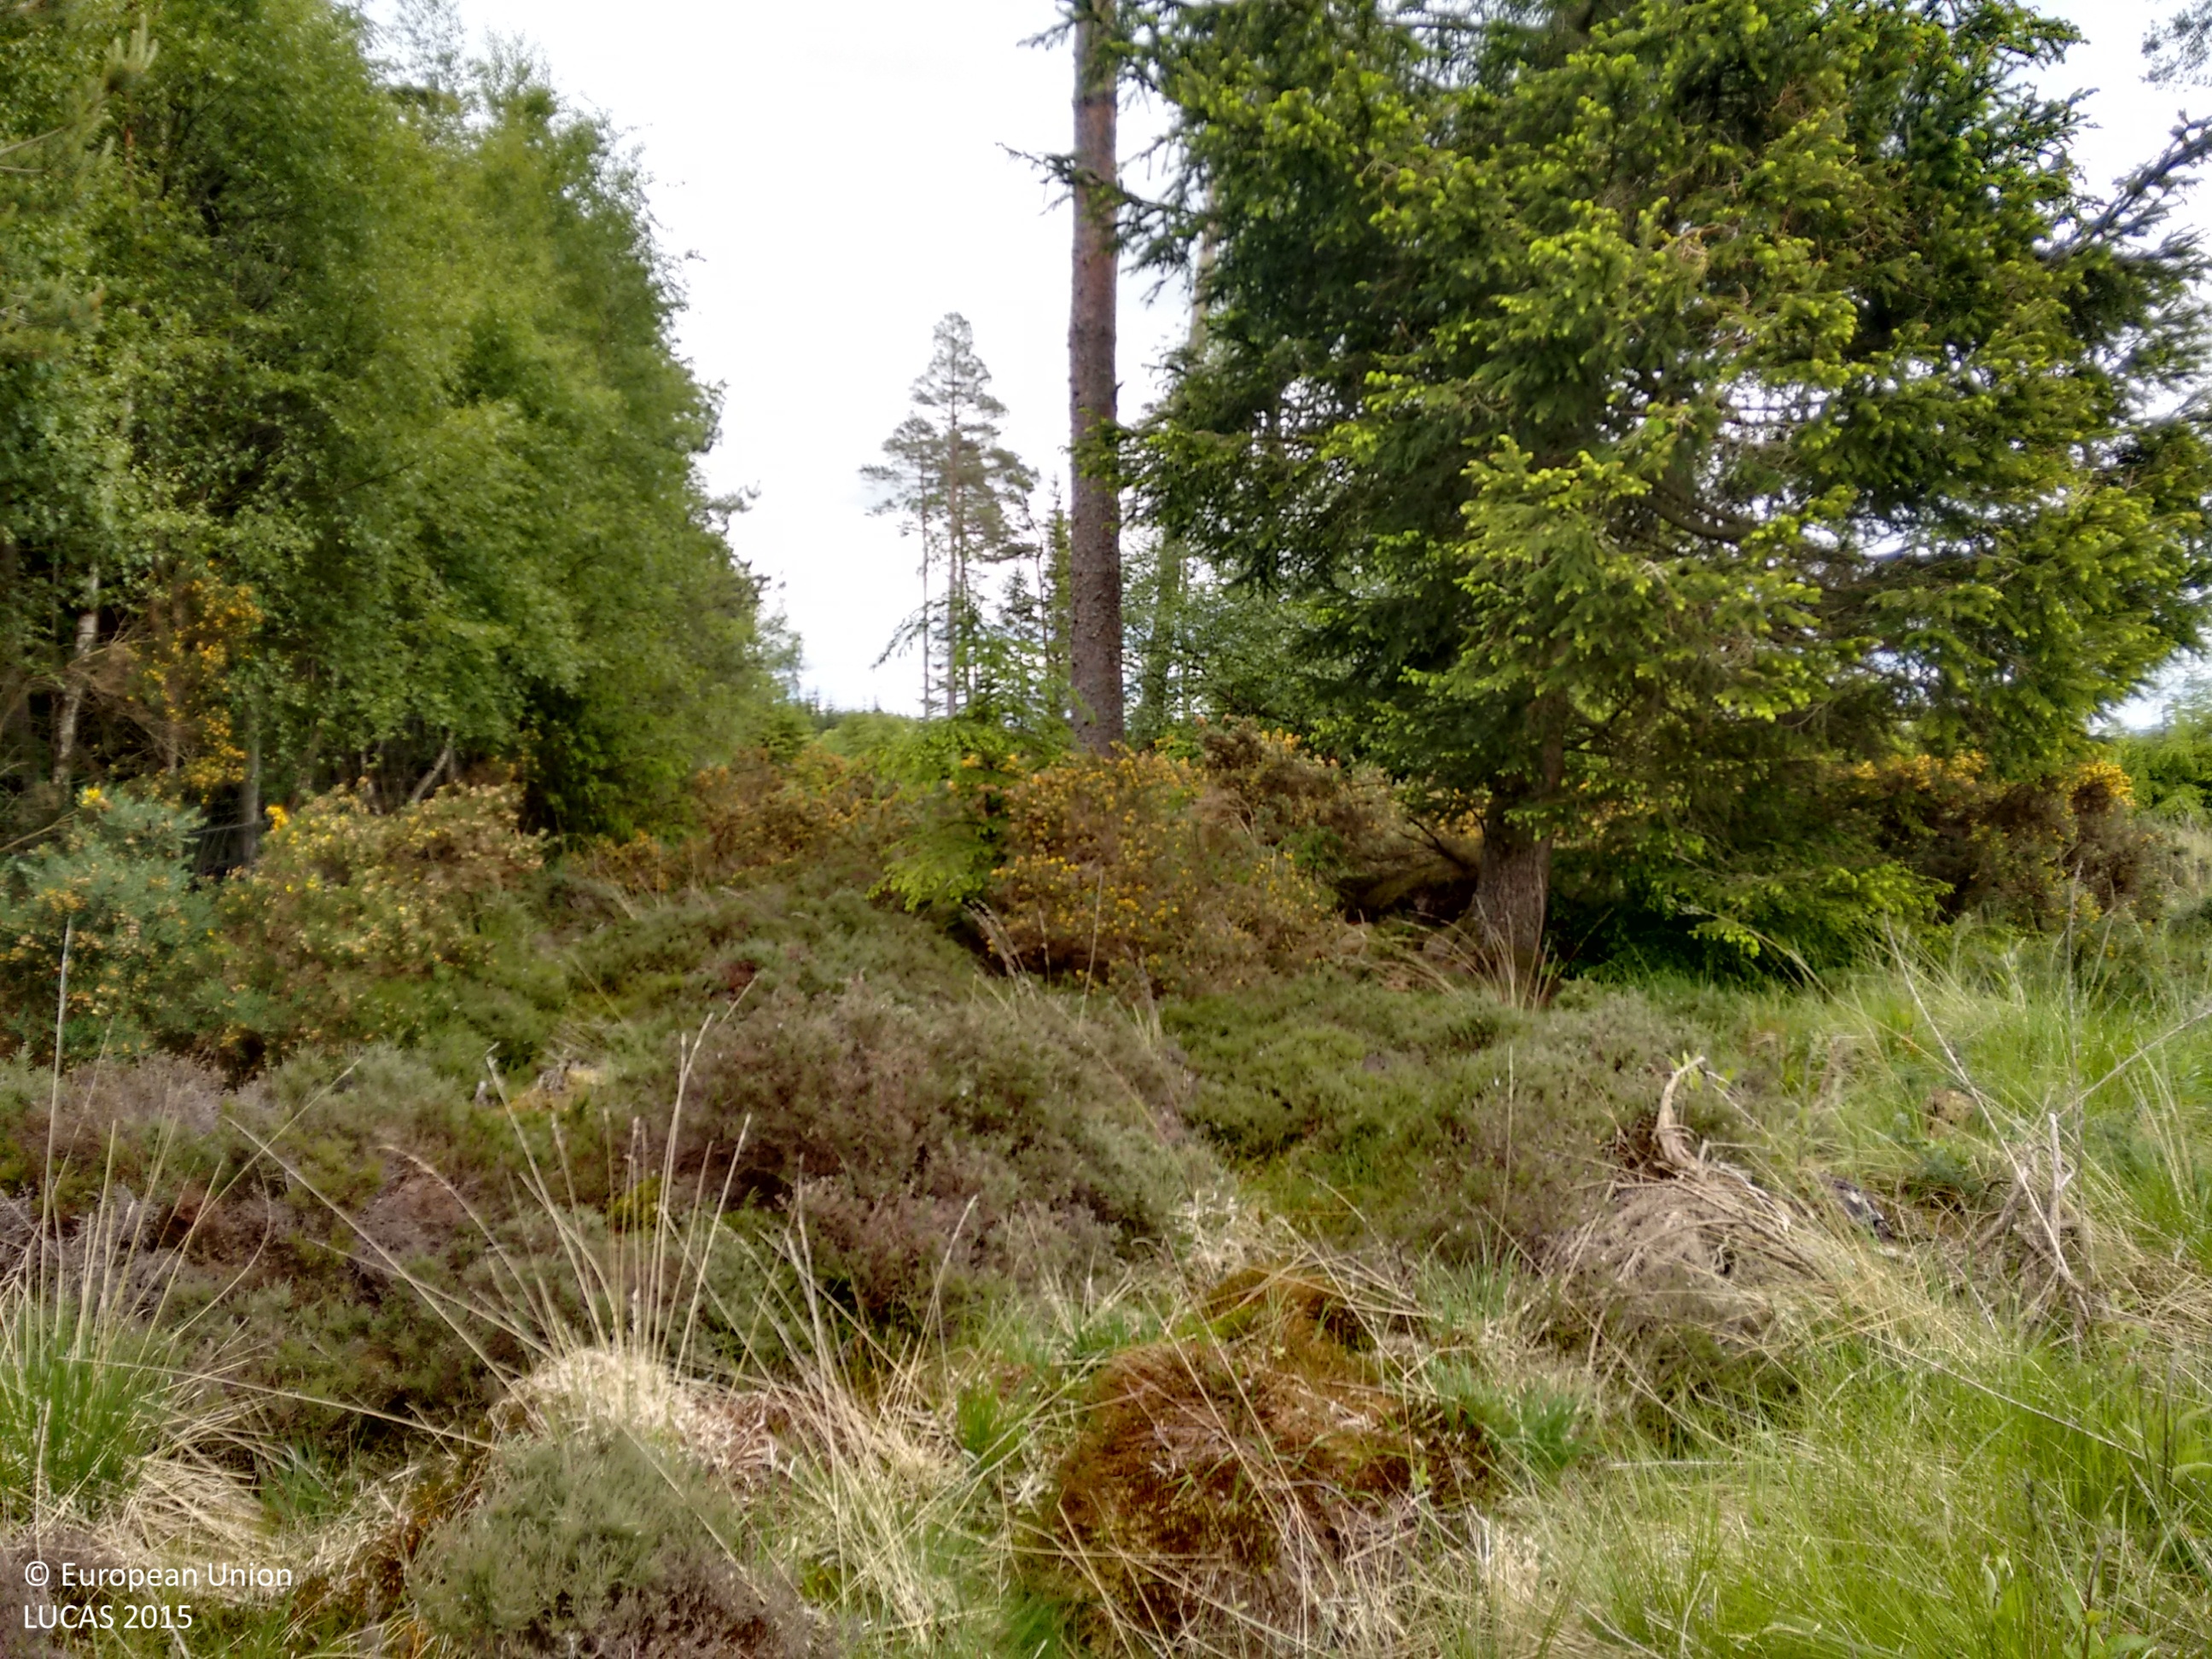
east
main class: Woodland
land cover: Spruce dominated coniferous woodland
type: exotic forest
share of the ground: > 75 %
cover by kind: coniferous forest trees 85 %, broadleaved forest trees 15 %
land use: Forestry
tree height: > 5 m
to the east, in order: Spruce dominated coniferous woodland; Fences; Shrubland with sparse tree cover; Fences; Lines of trees; Ditches and canals; Shrubland with sparse tree cover; Grass margins; Paved roads, cycling and walking lanes; Grass margins; Spruce dominated mixed woodland
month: June
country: GB
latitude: 56.5271
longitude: -3.5198
